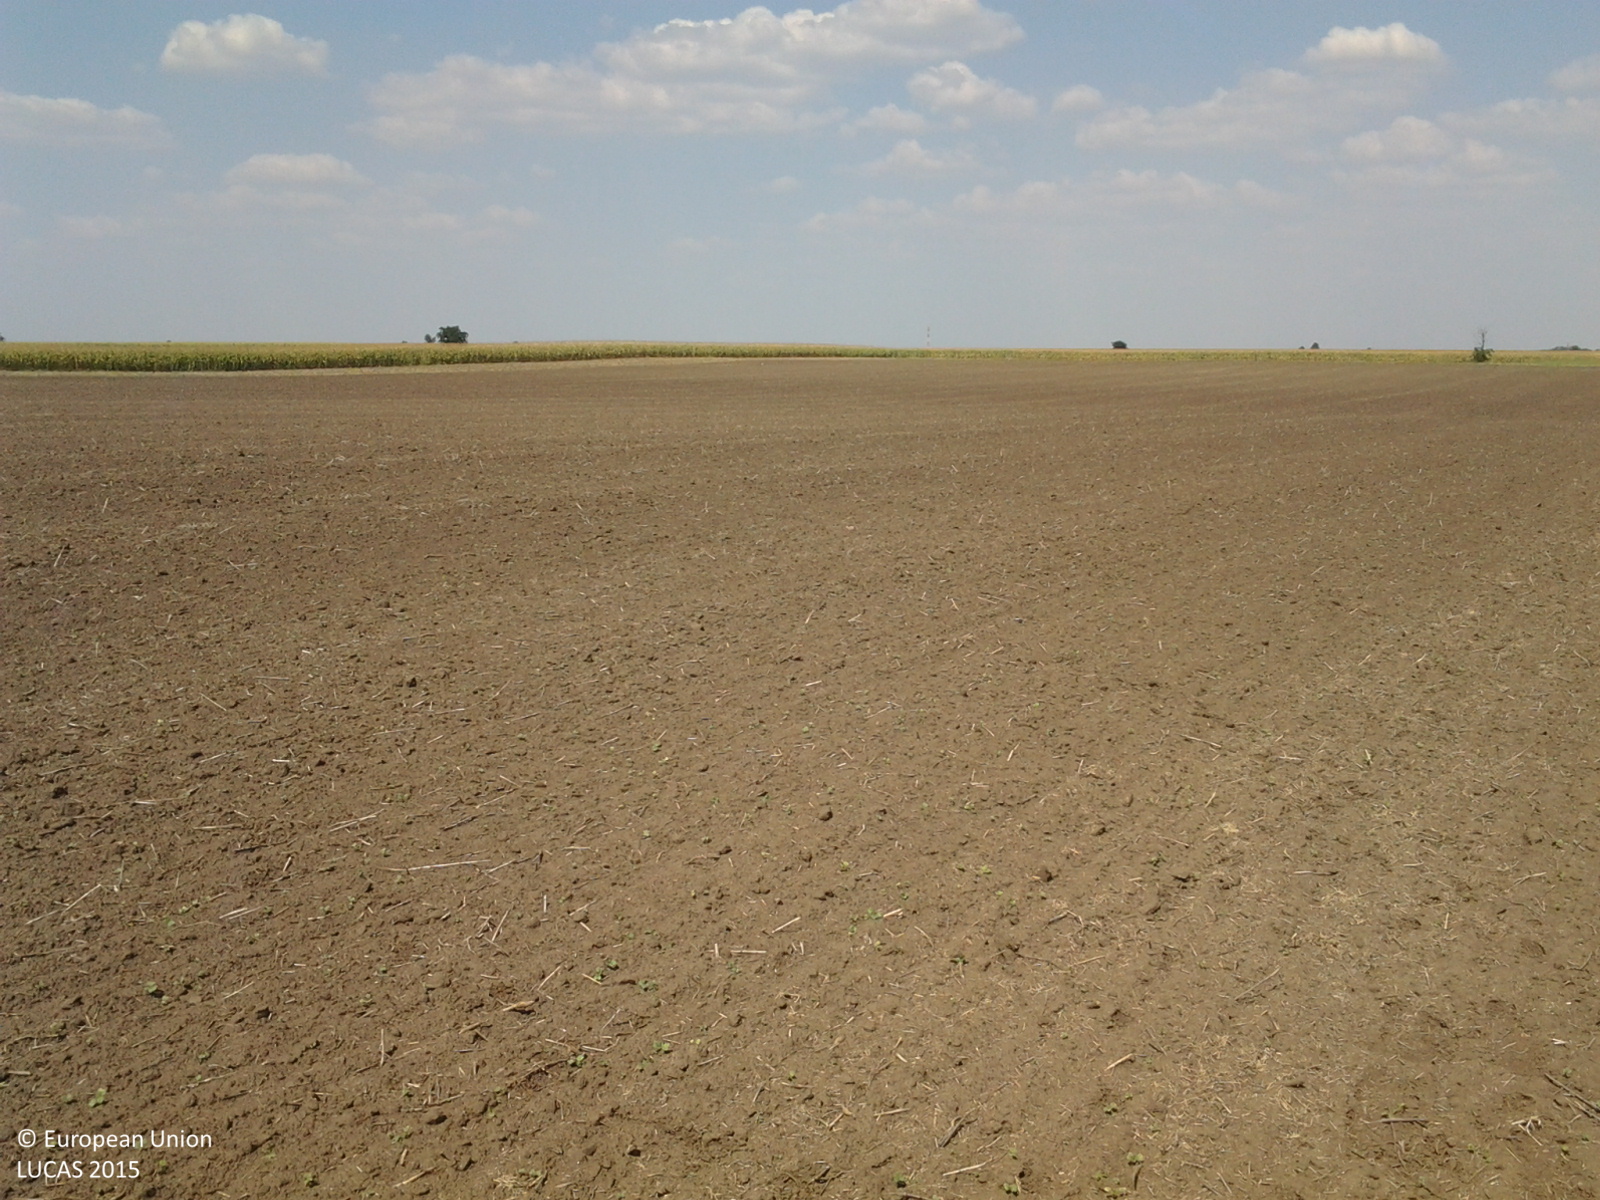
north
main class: Cropland
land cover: Rape and turnip rape
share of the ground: < 10 %
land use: Agriculture (excluding fallow land and kitchen gardens)
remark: Harvested field
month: August
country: HU
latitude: 47.3218
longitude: 19.7207
